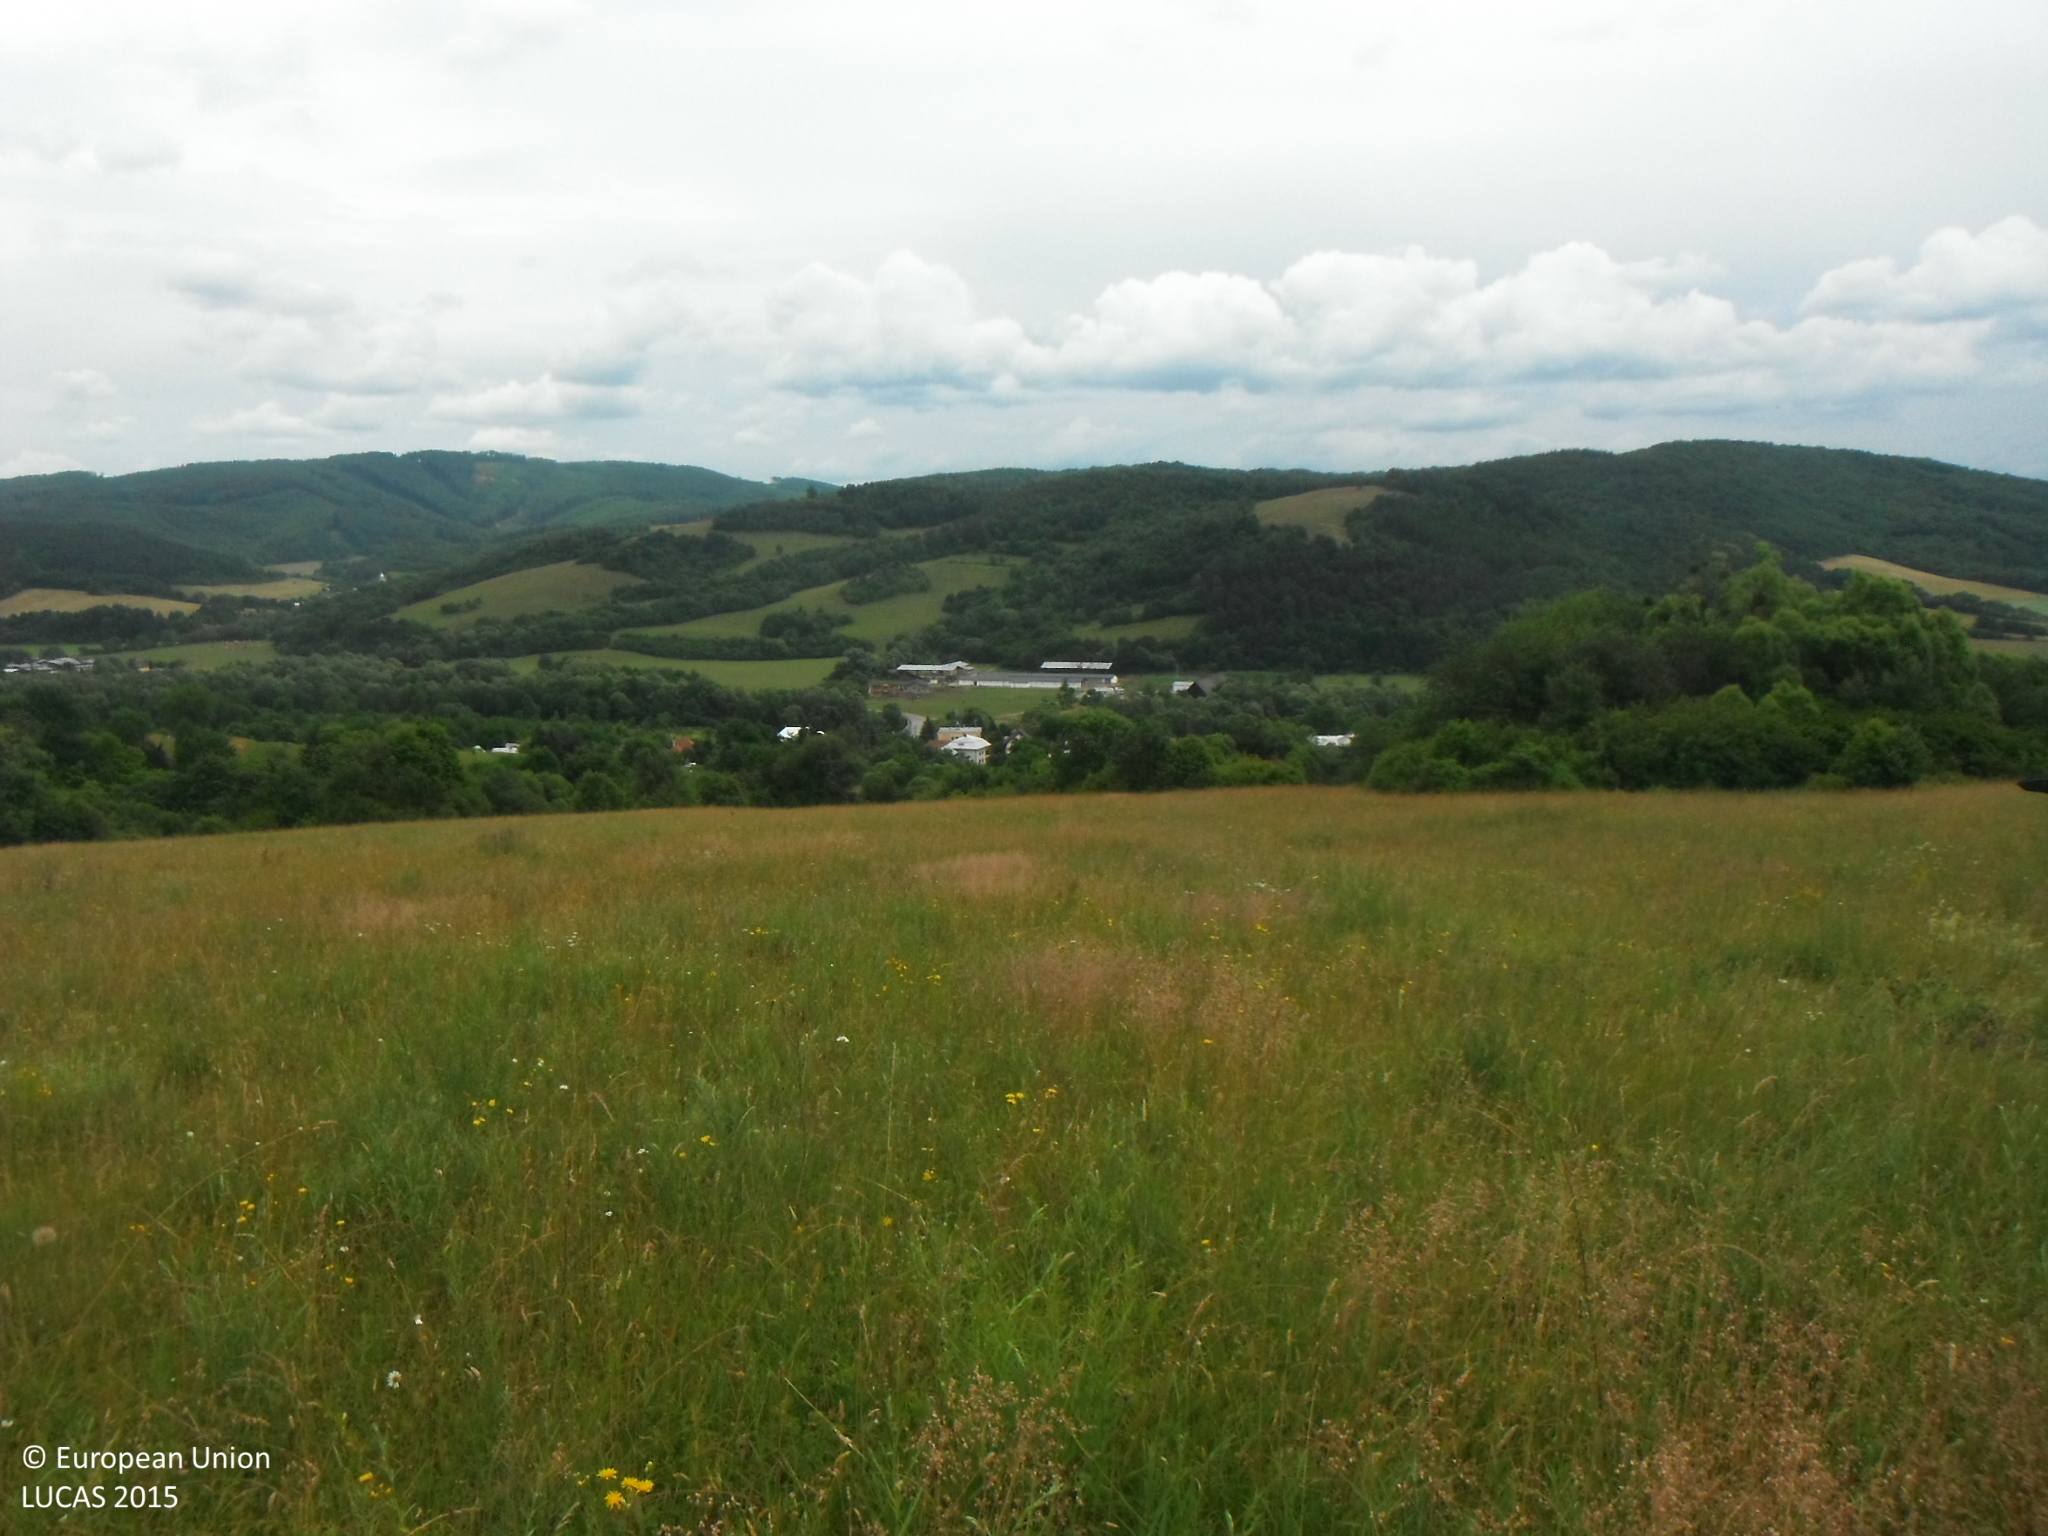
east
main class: Grassland
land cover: Grassland without tree/shrub cover
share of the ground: > 75 %
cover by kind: herbaceous plants 100 %
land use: Agriculture (excluding fallow land and kitchen gardens)
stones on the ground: < 10 %
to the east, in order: Grassland without tree/shrub cover; Tracks; Grassland without tree/shrub cover; Tracks; Grassland without tree/shrub cover
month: June
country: SK
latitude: 49.0269
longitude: 21.9393
